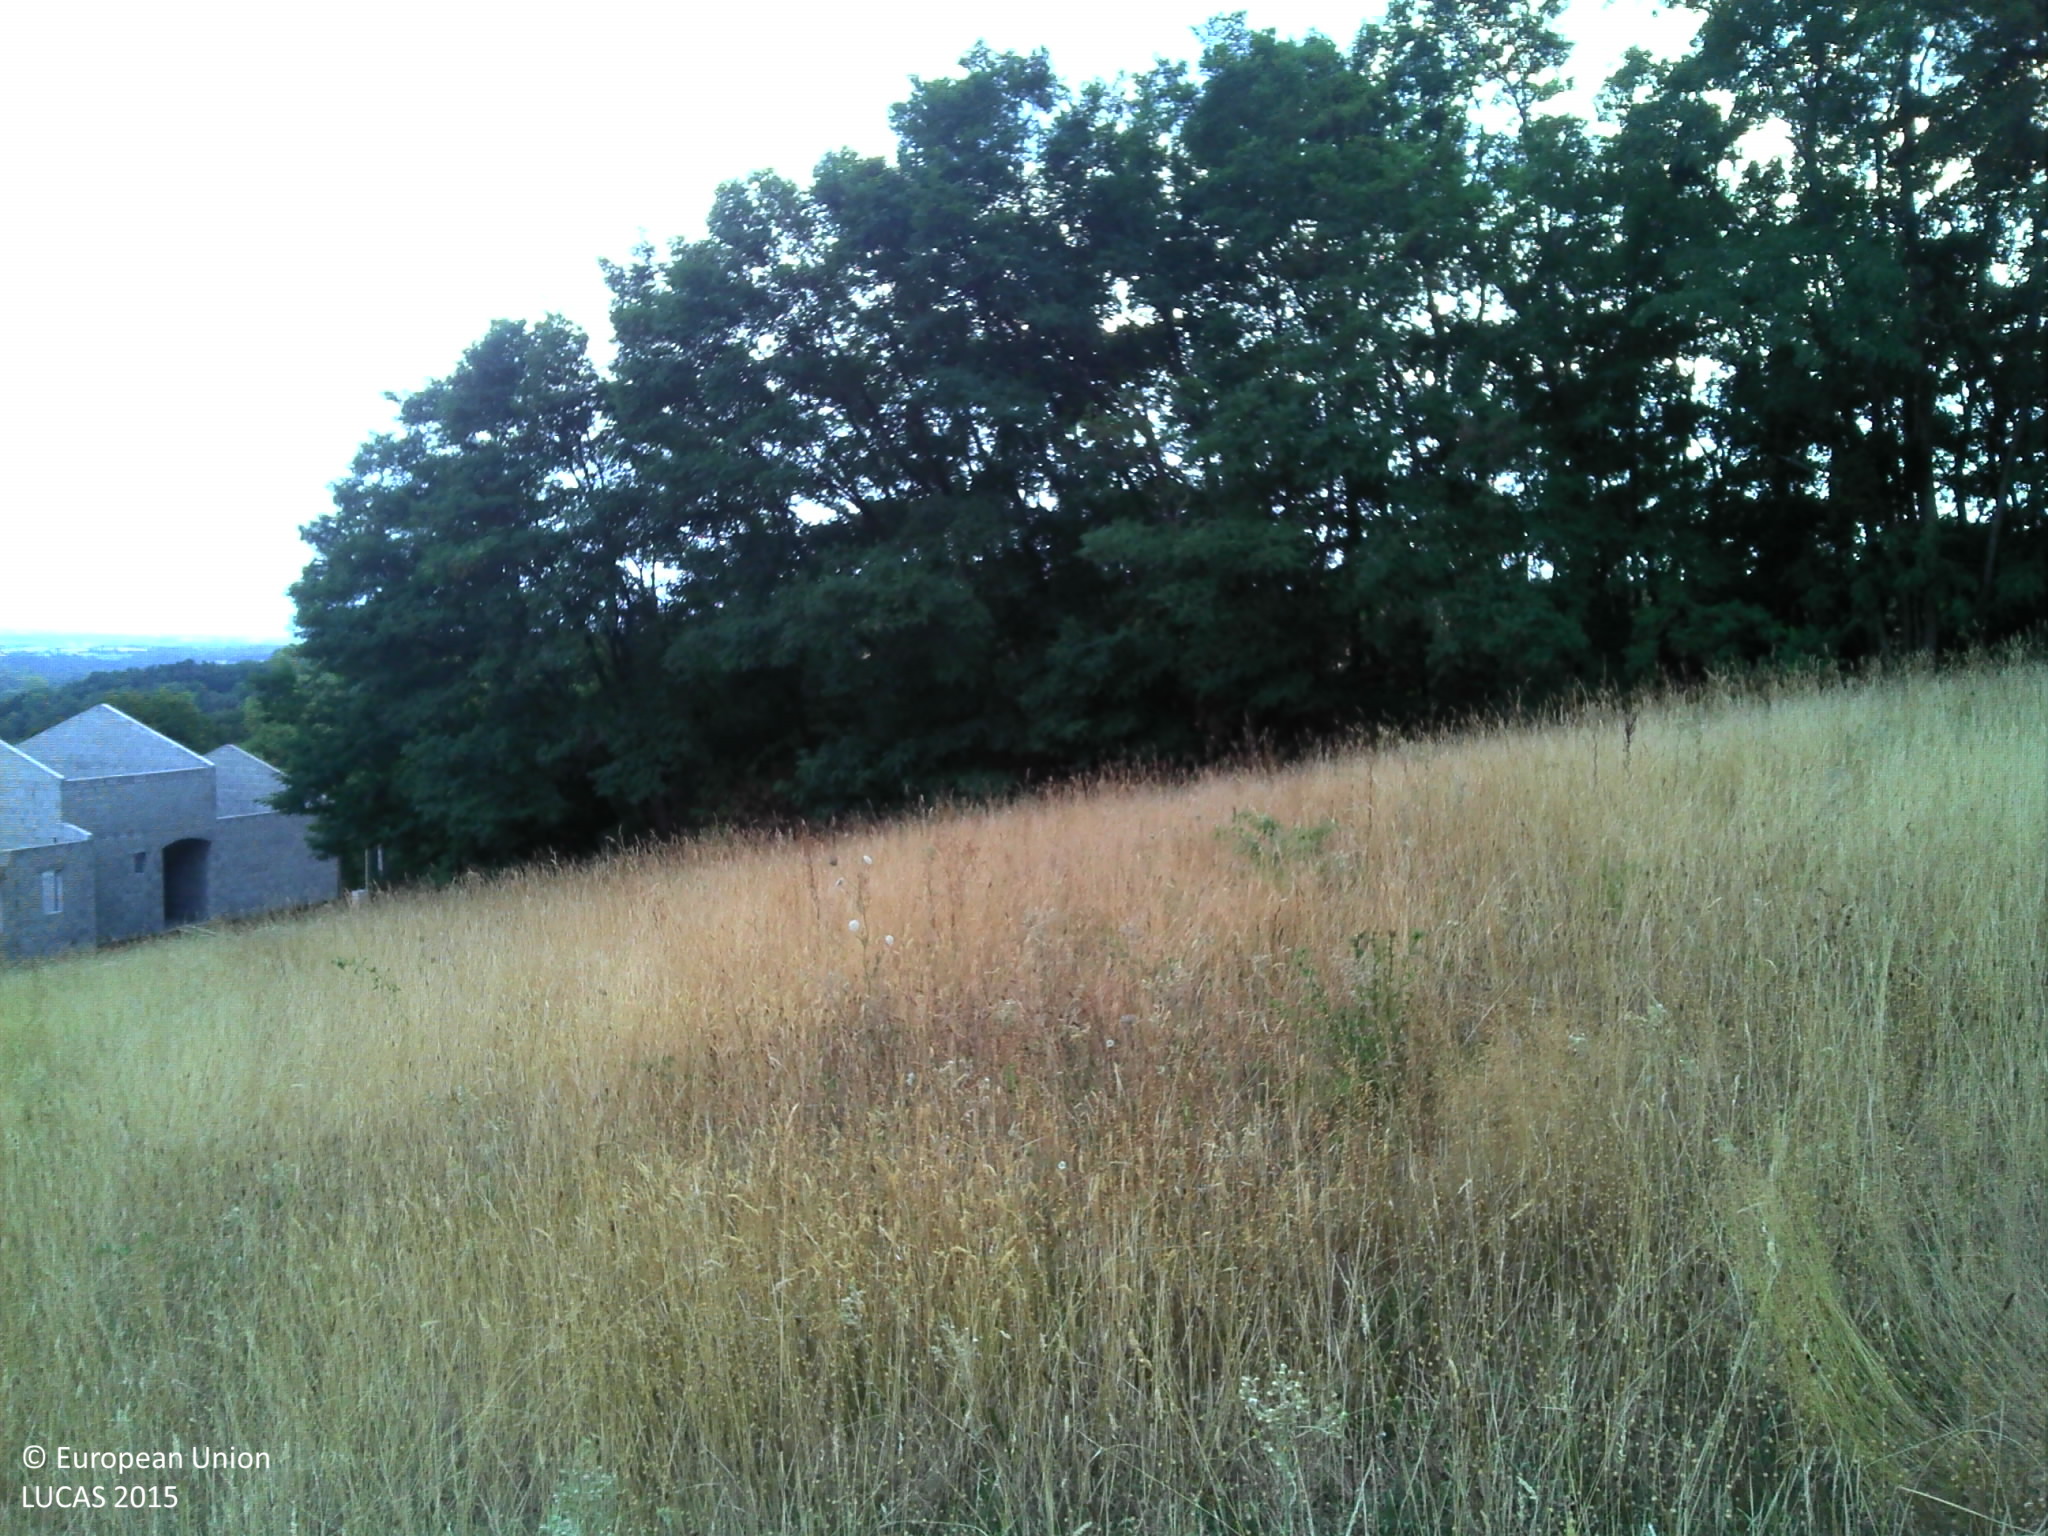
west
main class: Grassland
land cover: Grassland without tree/shrub cover
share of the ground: > 75 %
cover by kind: herbaceous plants 100 %
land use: Agriculture (excluding fallow land and kitchen gardens)
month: July
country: FR
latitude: 45.4069
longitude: 5.0601
